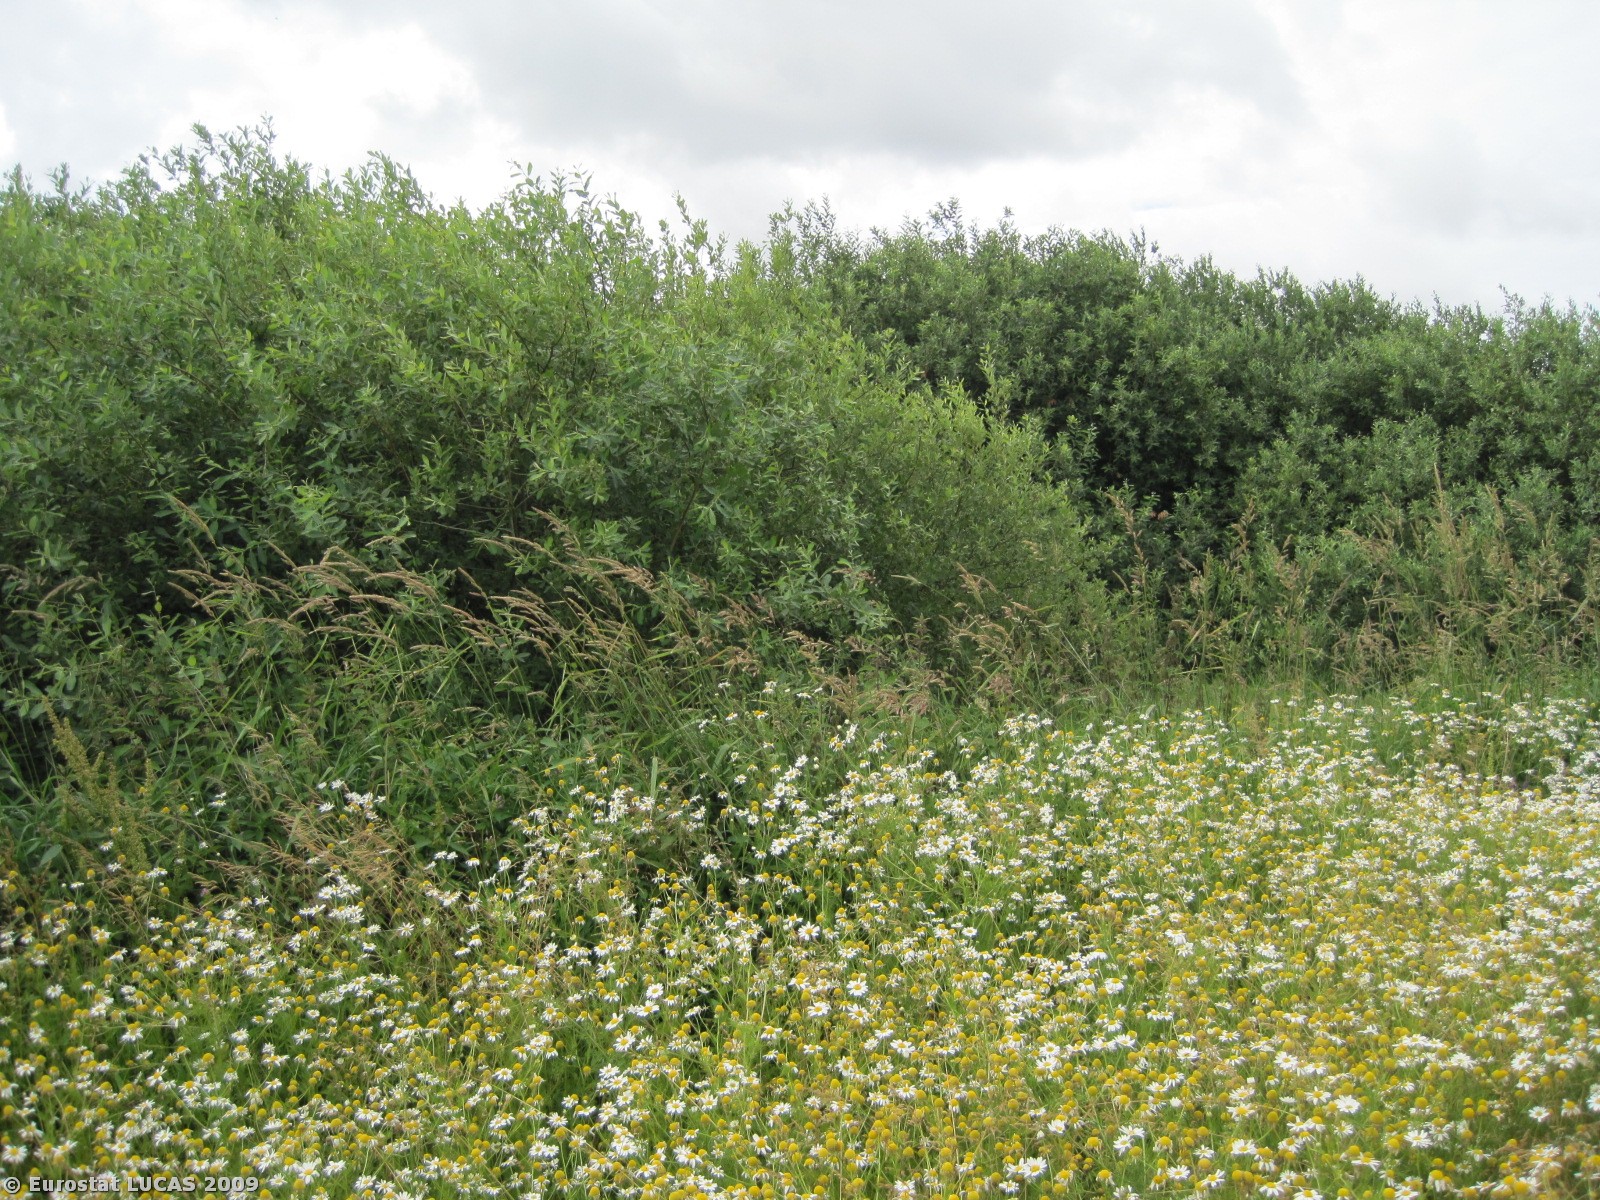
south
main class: Grassland
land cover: Grassland without tree/shrub cover
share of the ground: > 75 %
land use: Unused
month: July
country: DK
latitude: 56.3971
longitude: 8.7216
